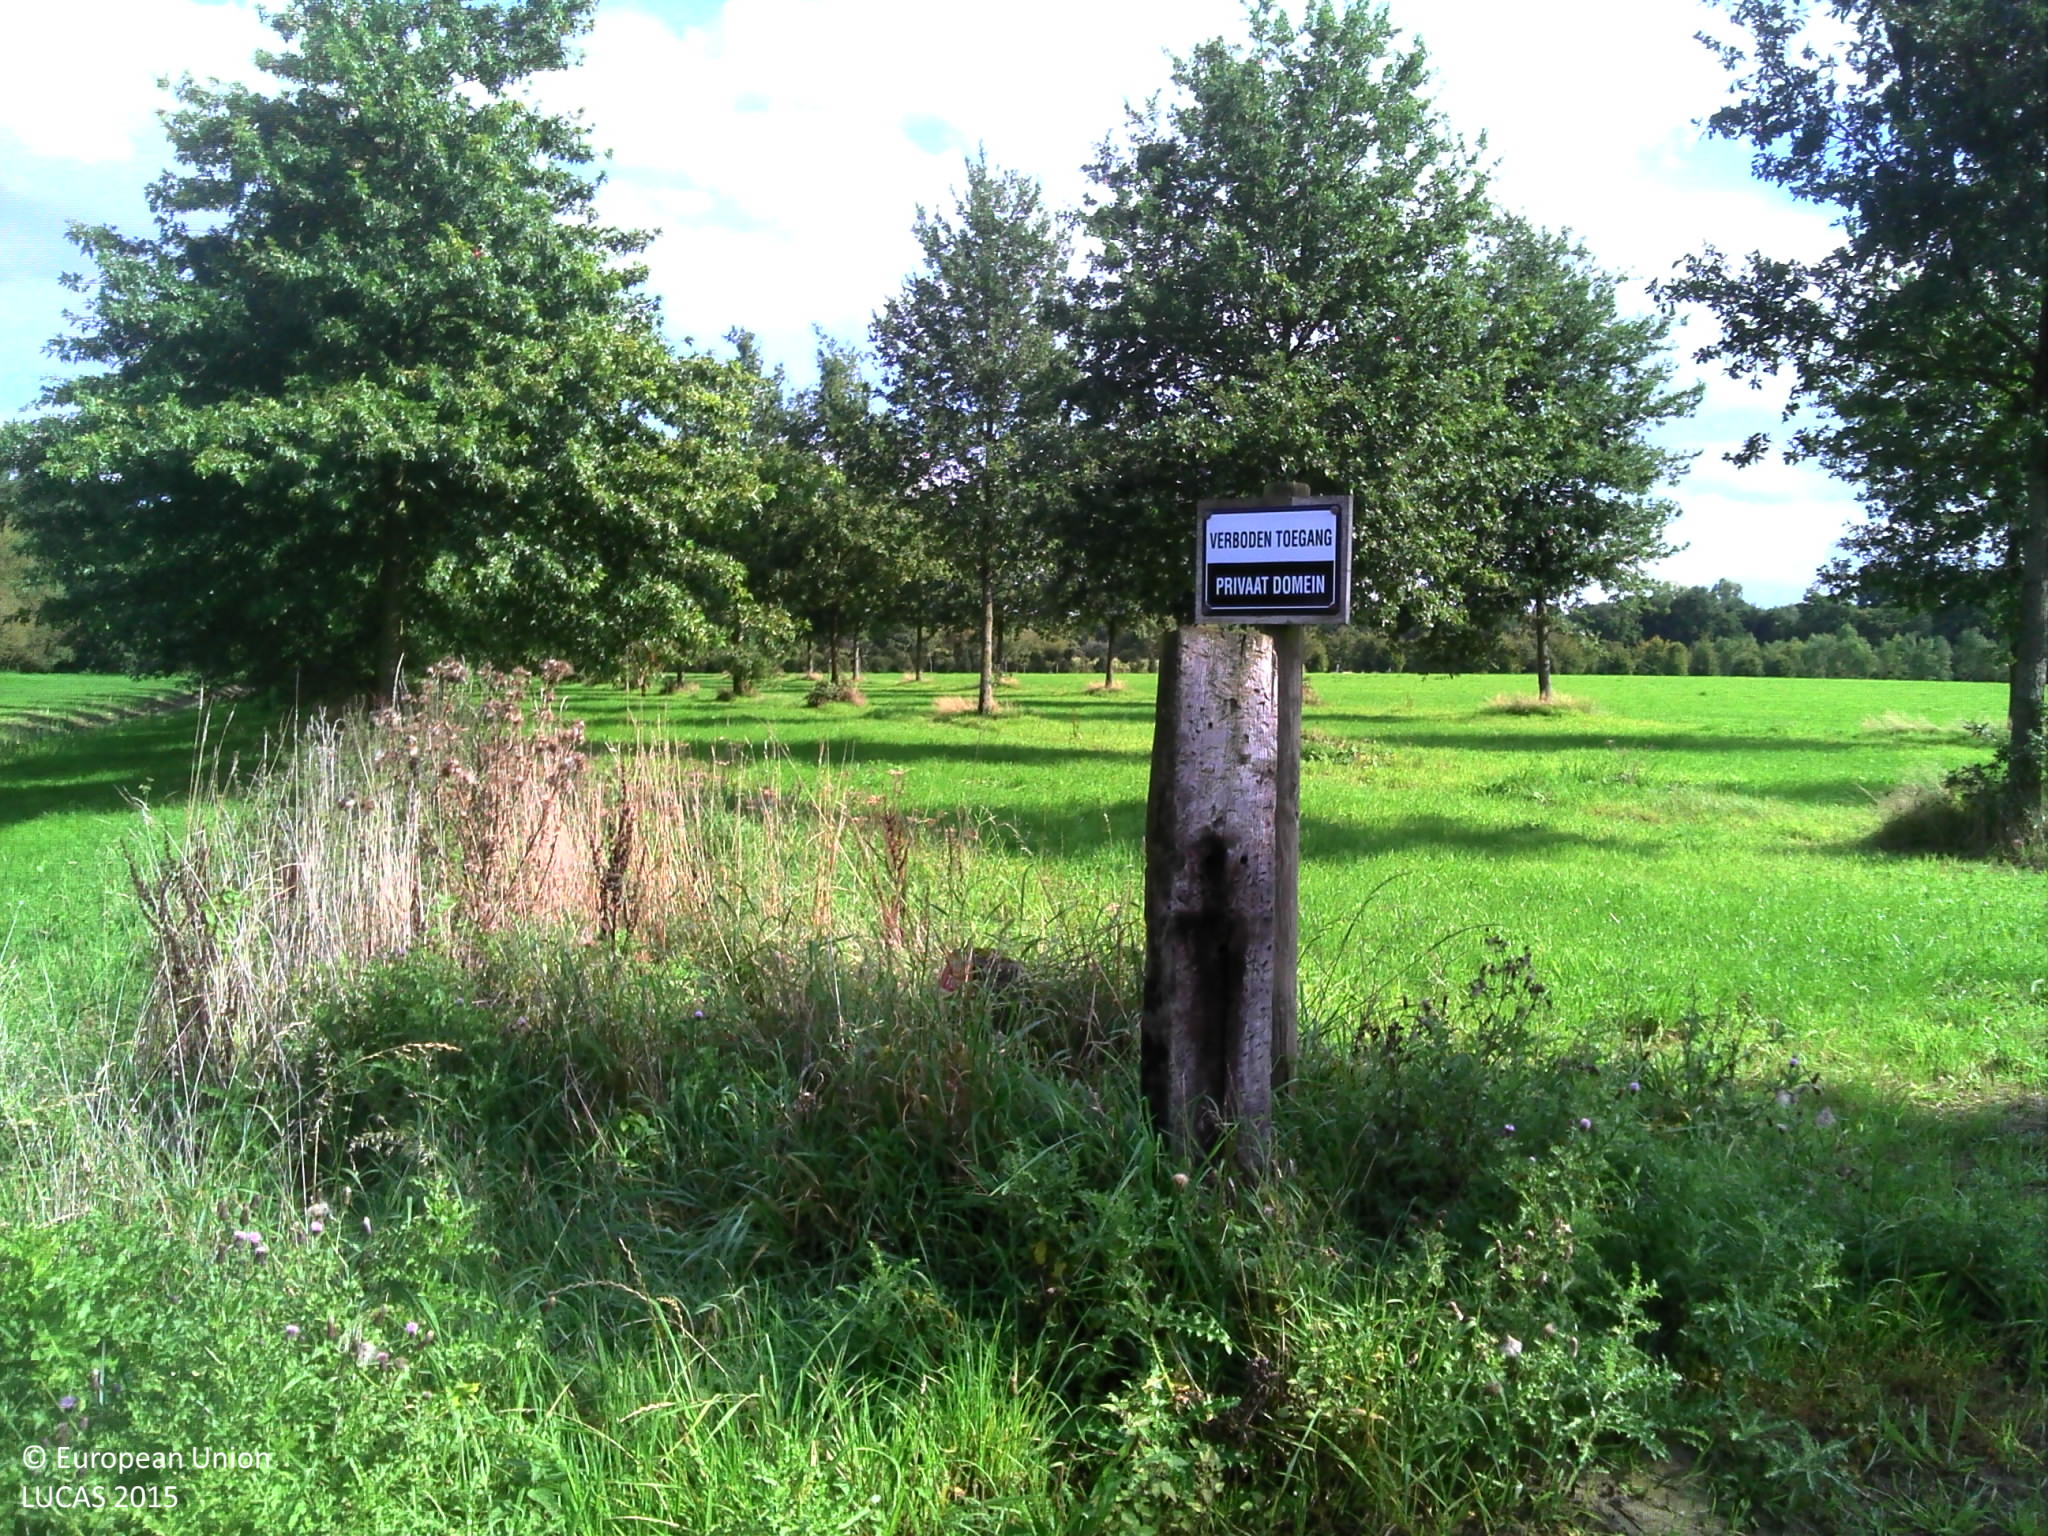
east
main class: Grassland
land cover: Grassland without tree/shrub cover
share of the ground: > 75 %
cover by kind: herbaceous plants 100 %
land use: Agriculture (excluding fallow land and kitchen gardens)
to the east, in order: Grassland without tree/shrub cover
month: September
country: BE
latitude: 51.1227
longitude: 4.6670
